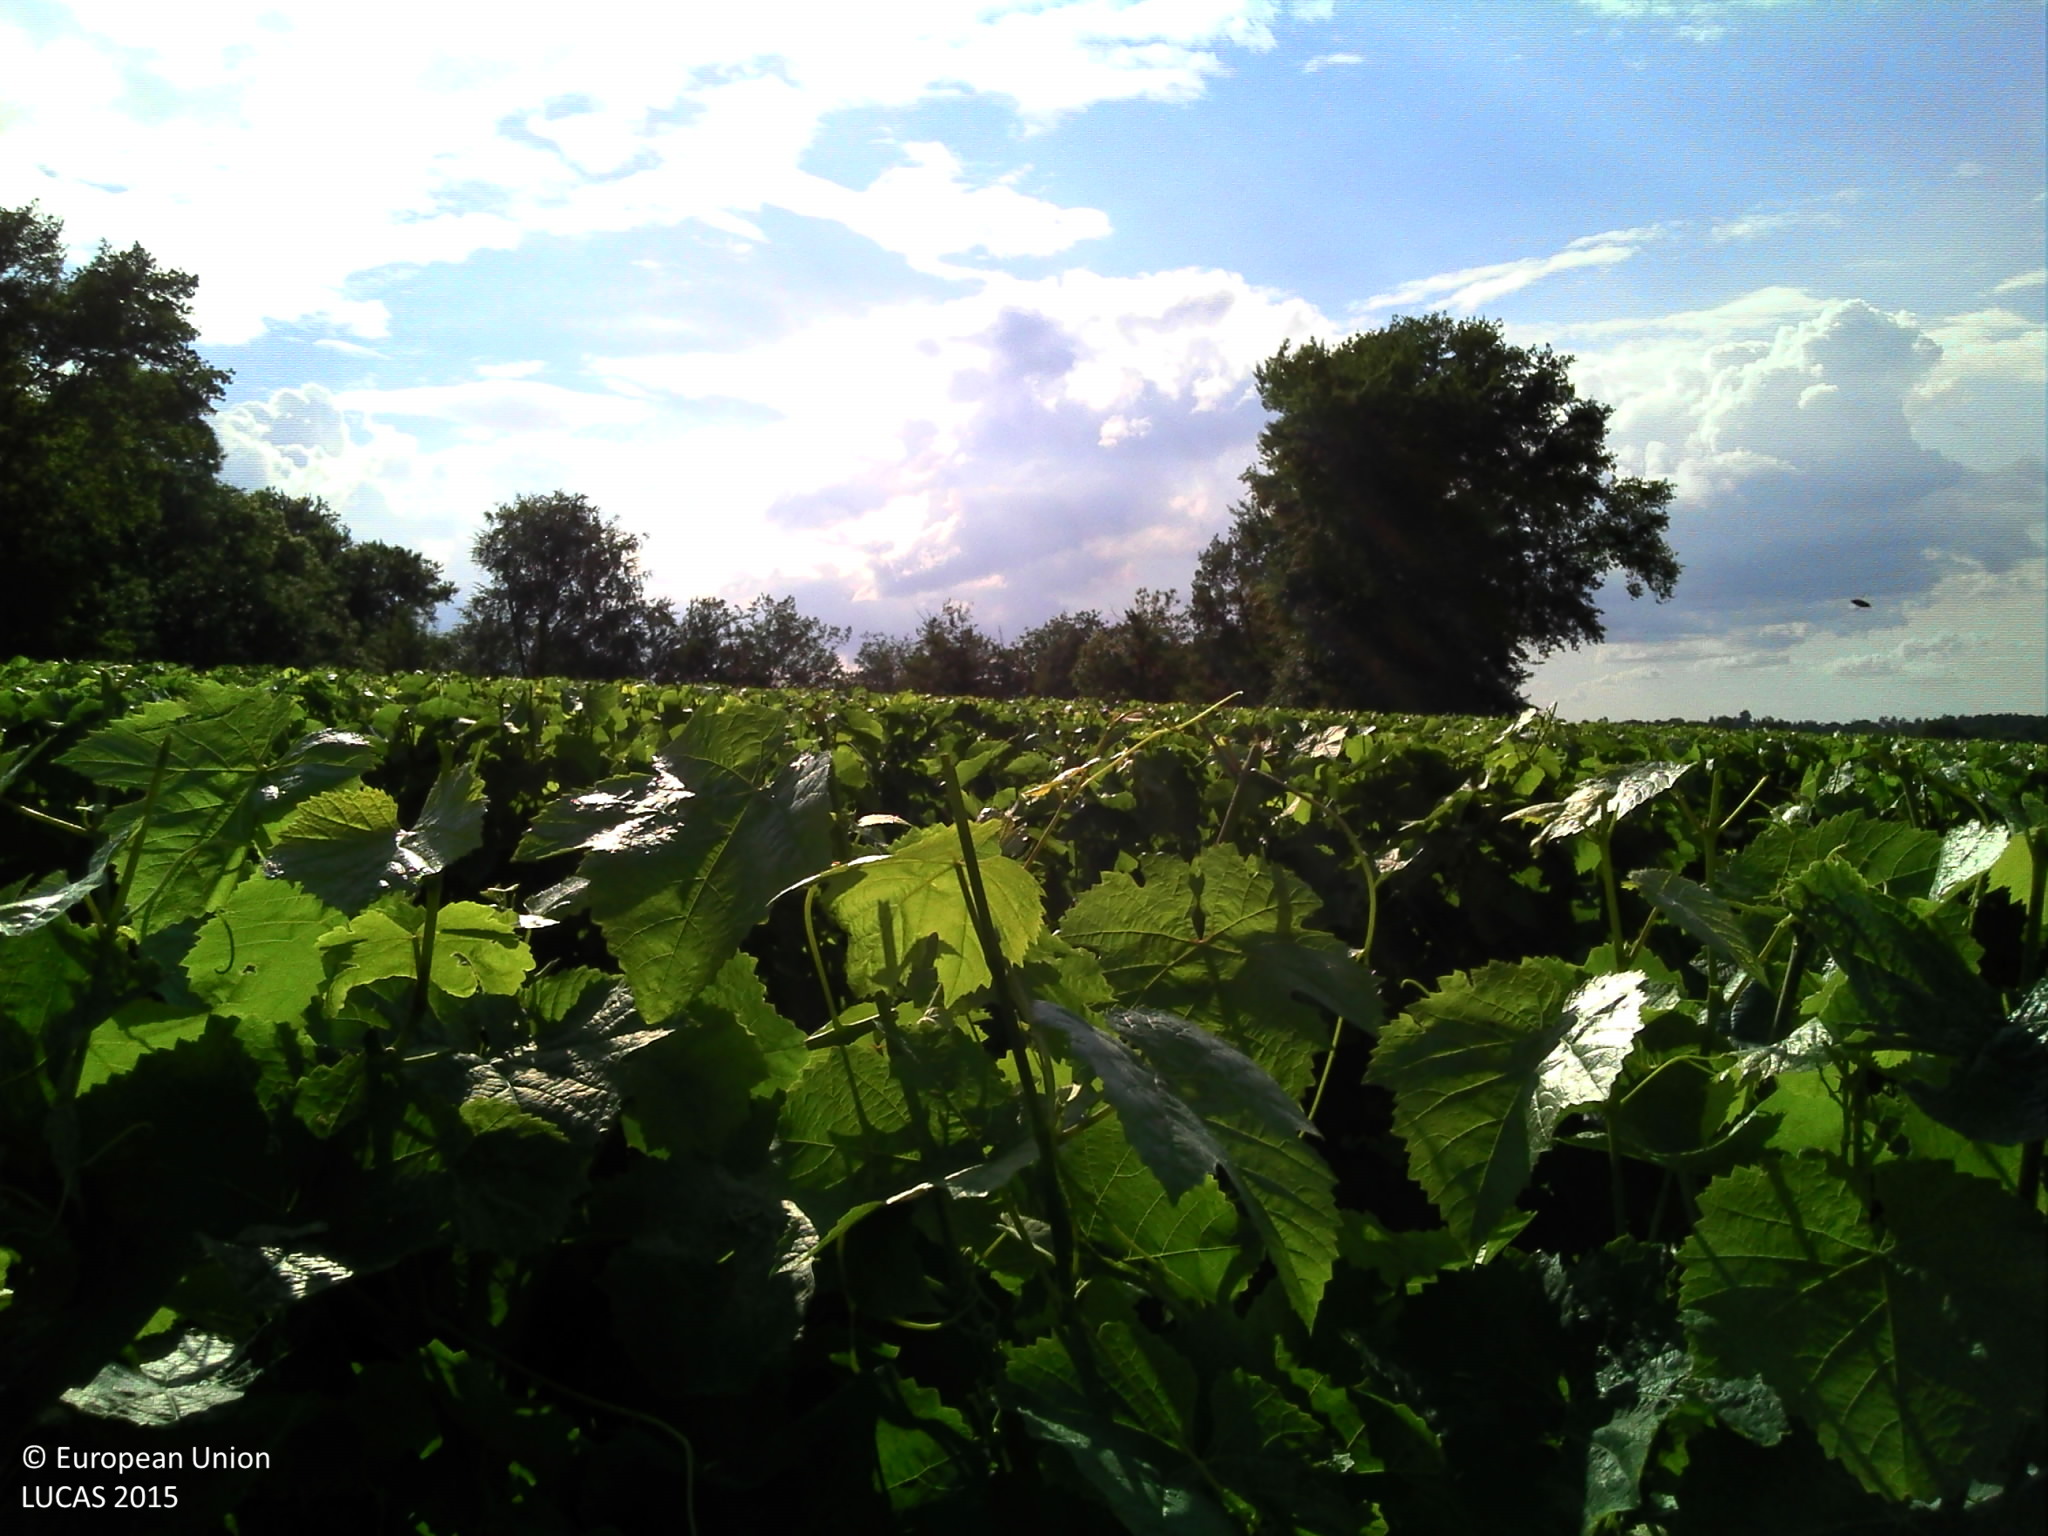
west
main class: Cropland
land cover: Vineyards
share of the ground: 25 - 50 %
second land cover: Grassland without tree/shrub cover
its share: 25 - 50 %
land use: Agriculture (excluding fallow land and kitchen gardens)
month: June
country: FR
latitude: 43.8421
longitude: -0.2459
